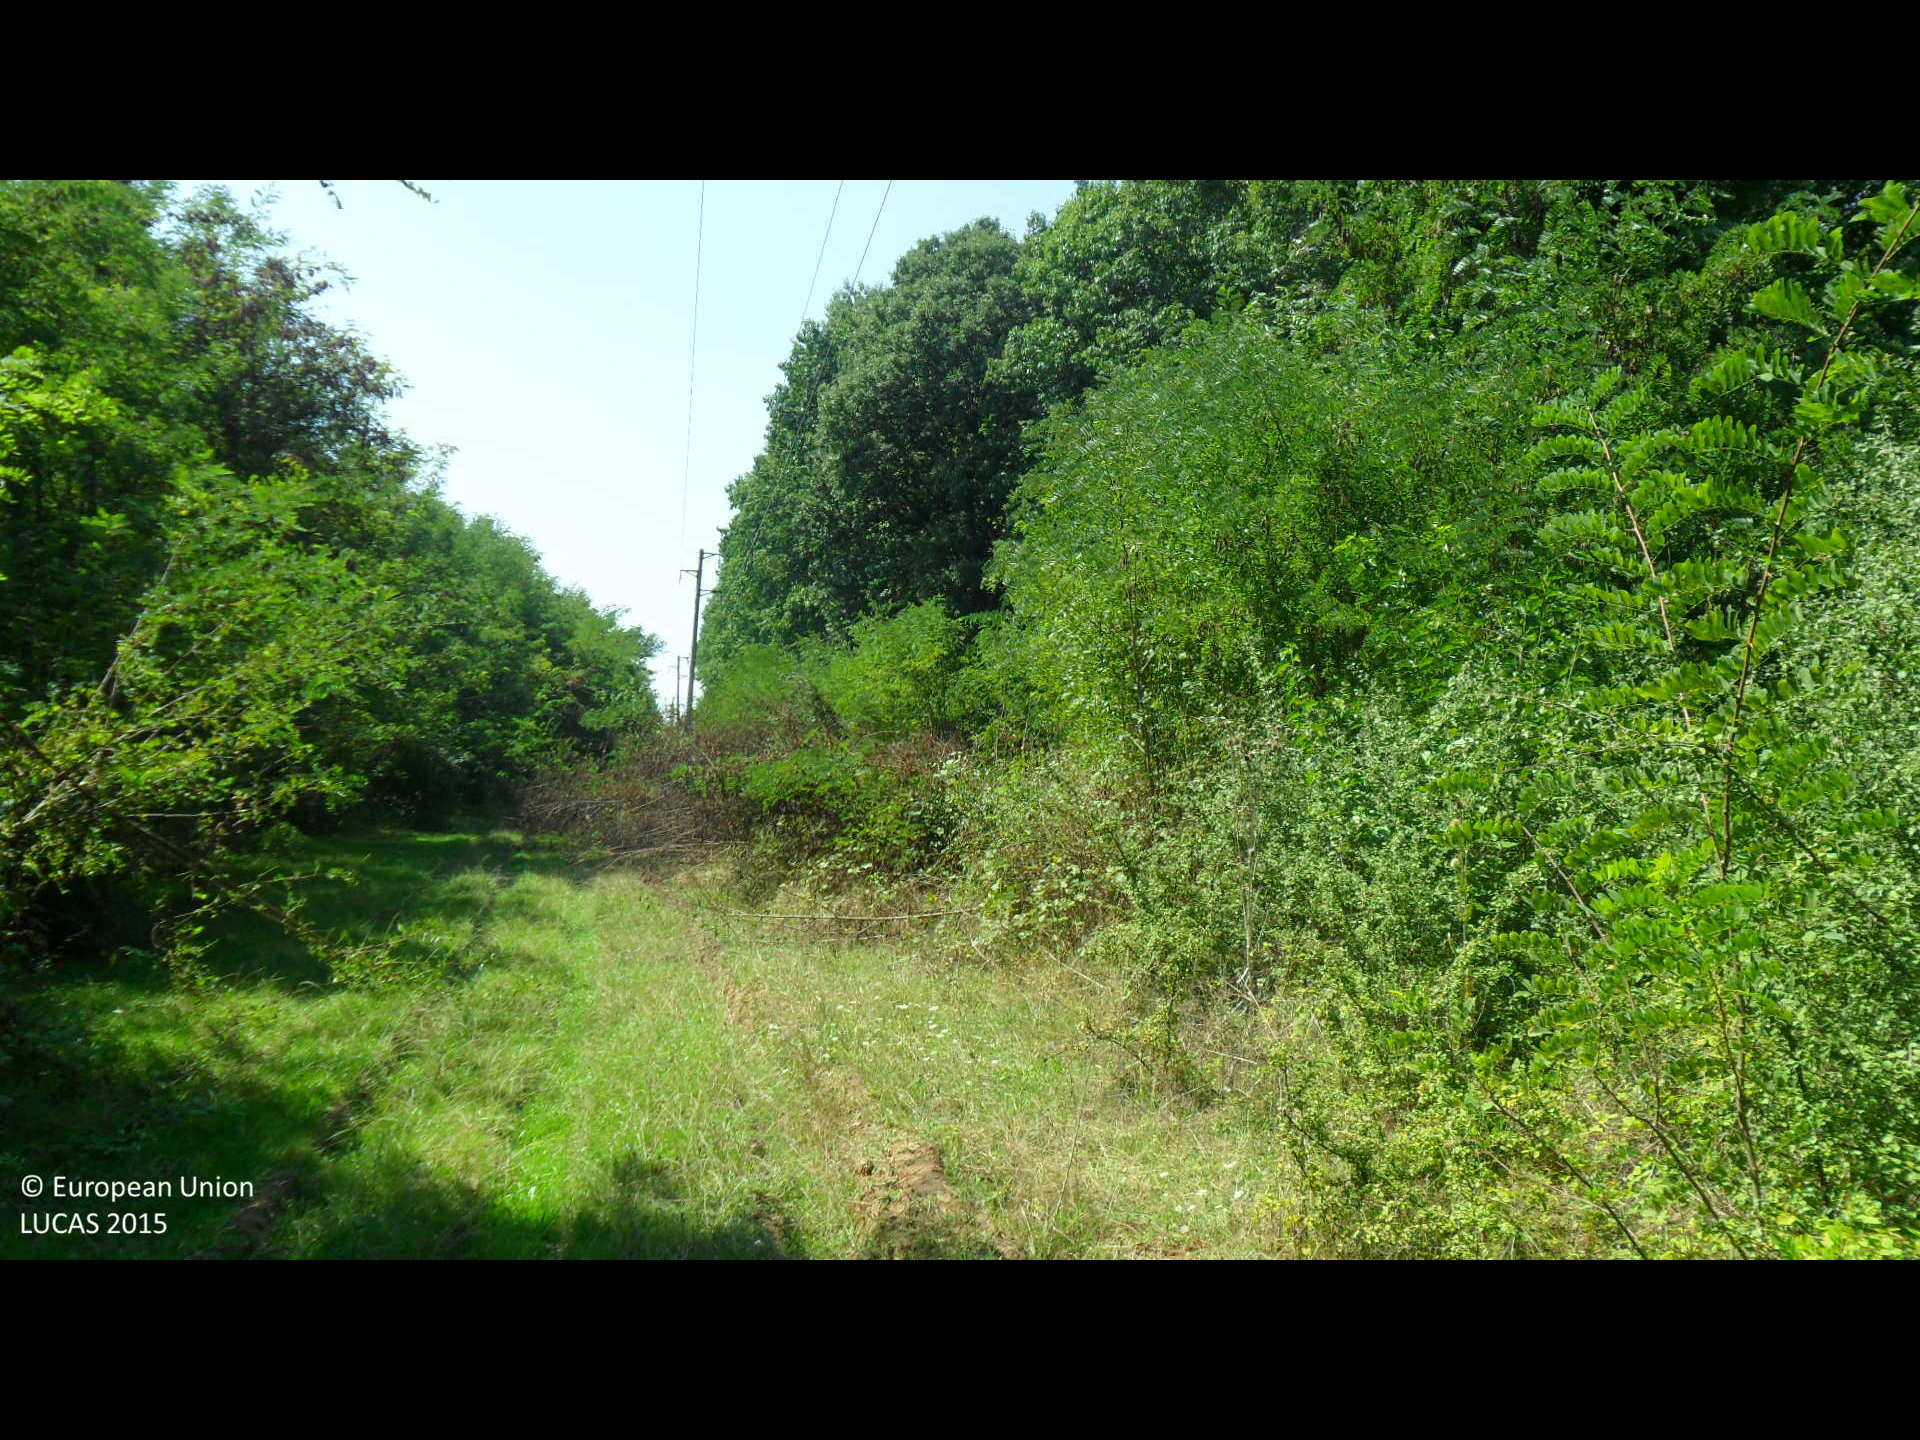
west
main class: Woodland
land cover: Broadleaved woodland
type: mesophytic deciduous forest
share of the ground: > 75 %
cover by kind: broadleaved forest trees 100 %
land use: Forestry
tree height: > 5 m
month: August
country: BG
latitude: 43.2223
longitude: 26.7144
